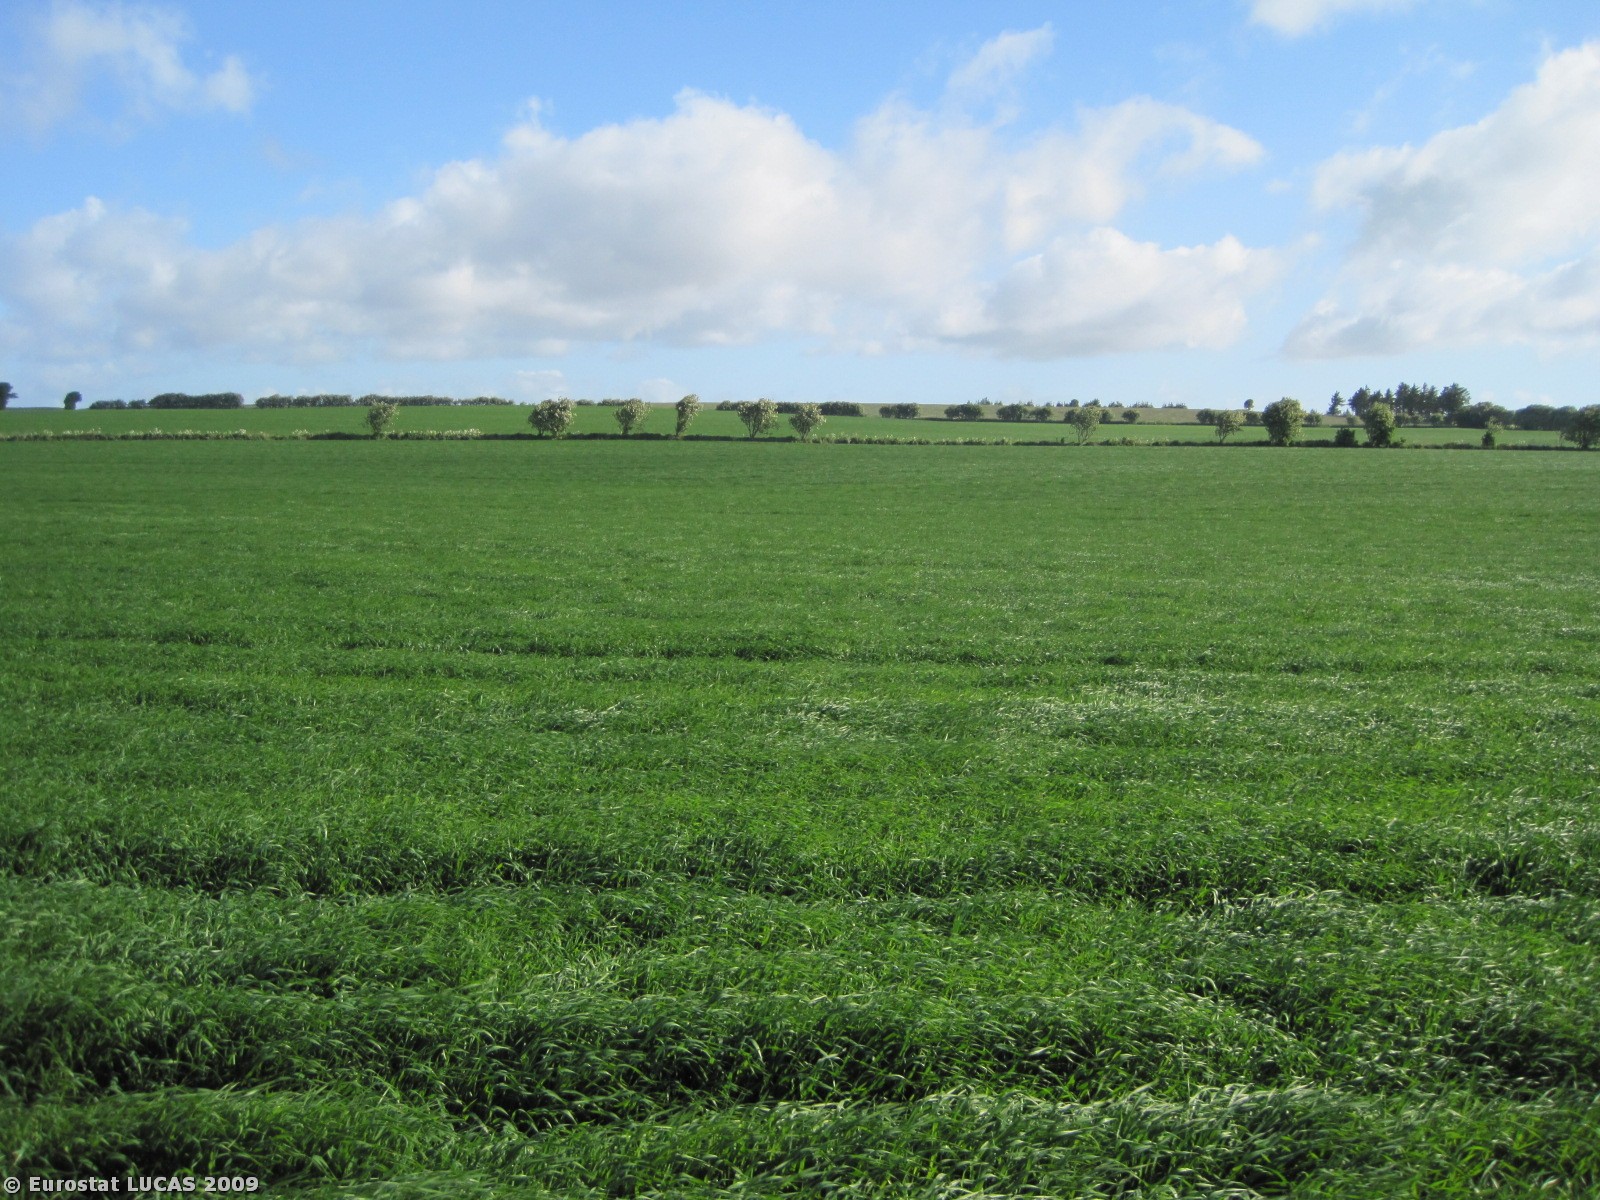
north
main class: Woodland
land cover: Broadleaved woodland
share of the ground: > 75 %
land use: Unused
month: May
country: DK
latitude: 56.5832
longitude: 10.0813
